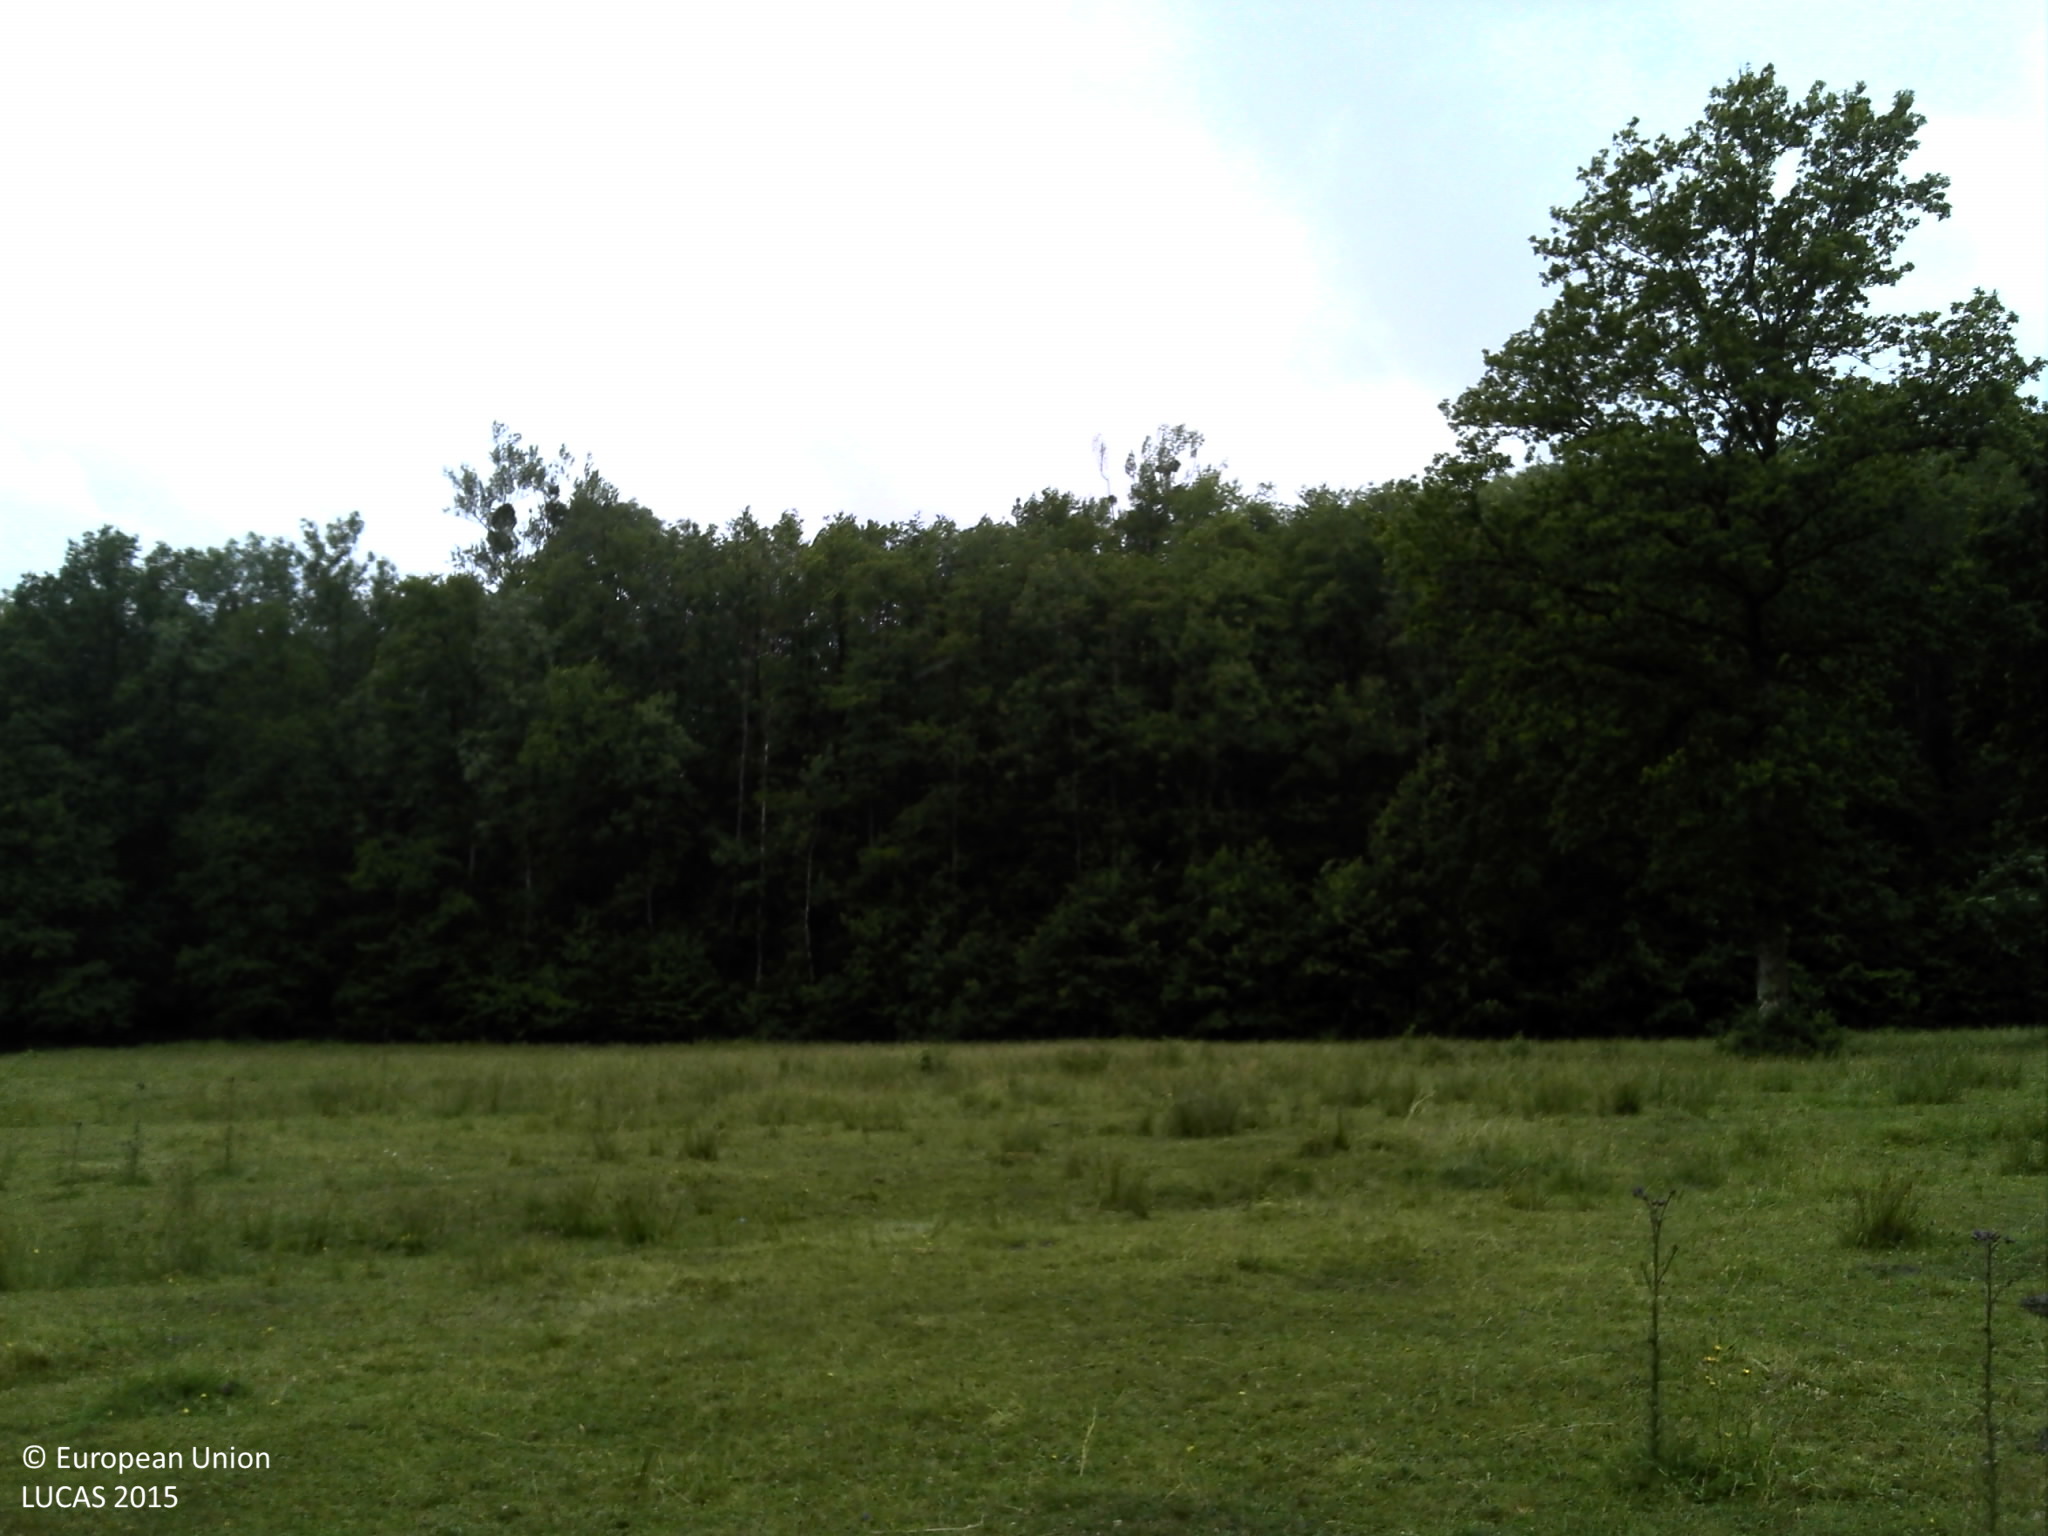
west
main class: Grassland
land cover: Grassland without tree/shrub cover
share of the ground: > 75 %
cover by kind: herbaceous plants 100 %
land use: Agriculture (excluding fallow land and kitchen gardens)
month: June
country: FR
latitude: 49.5603
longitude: 4.7849
